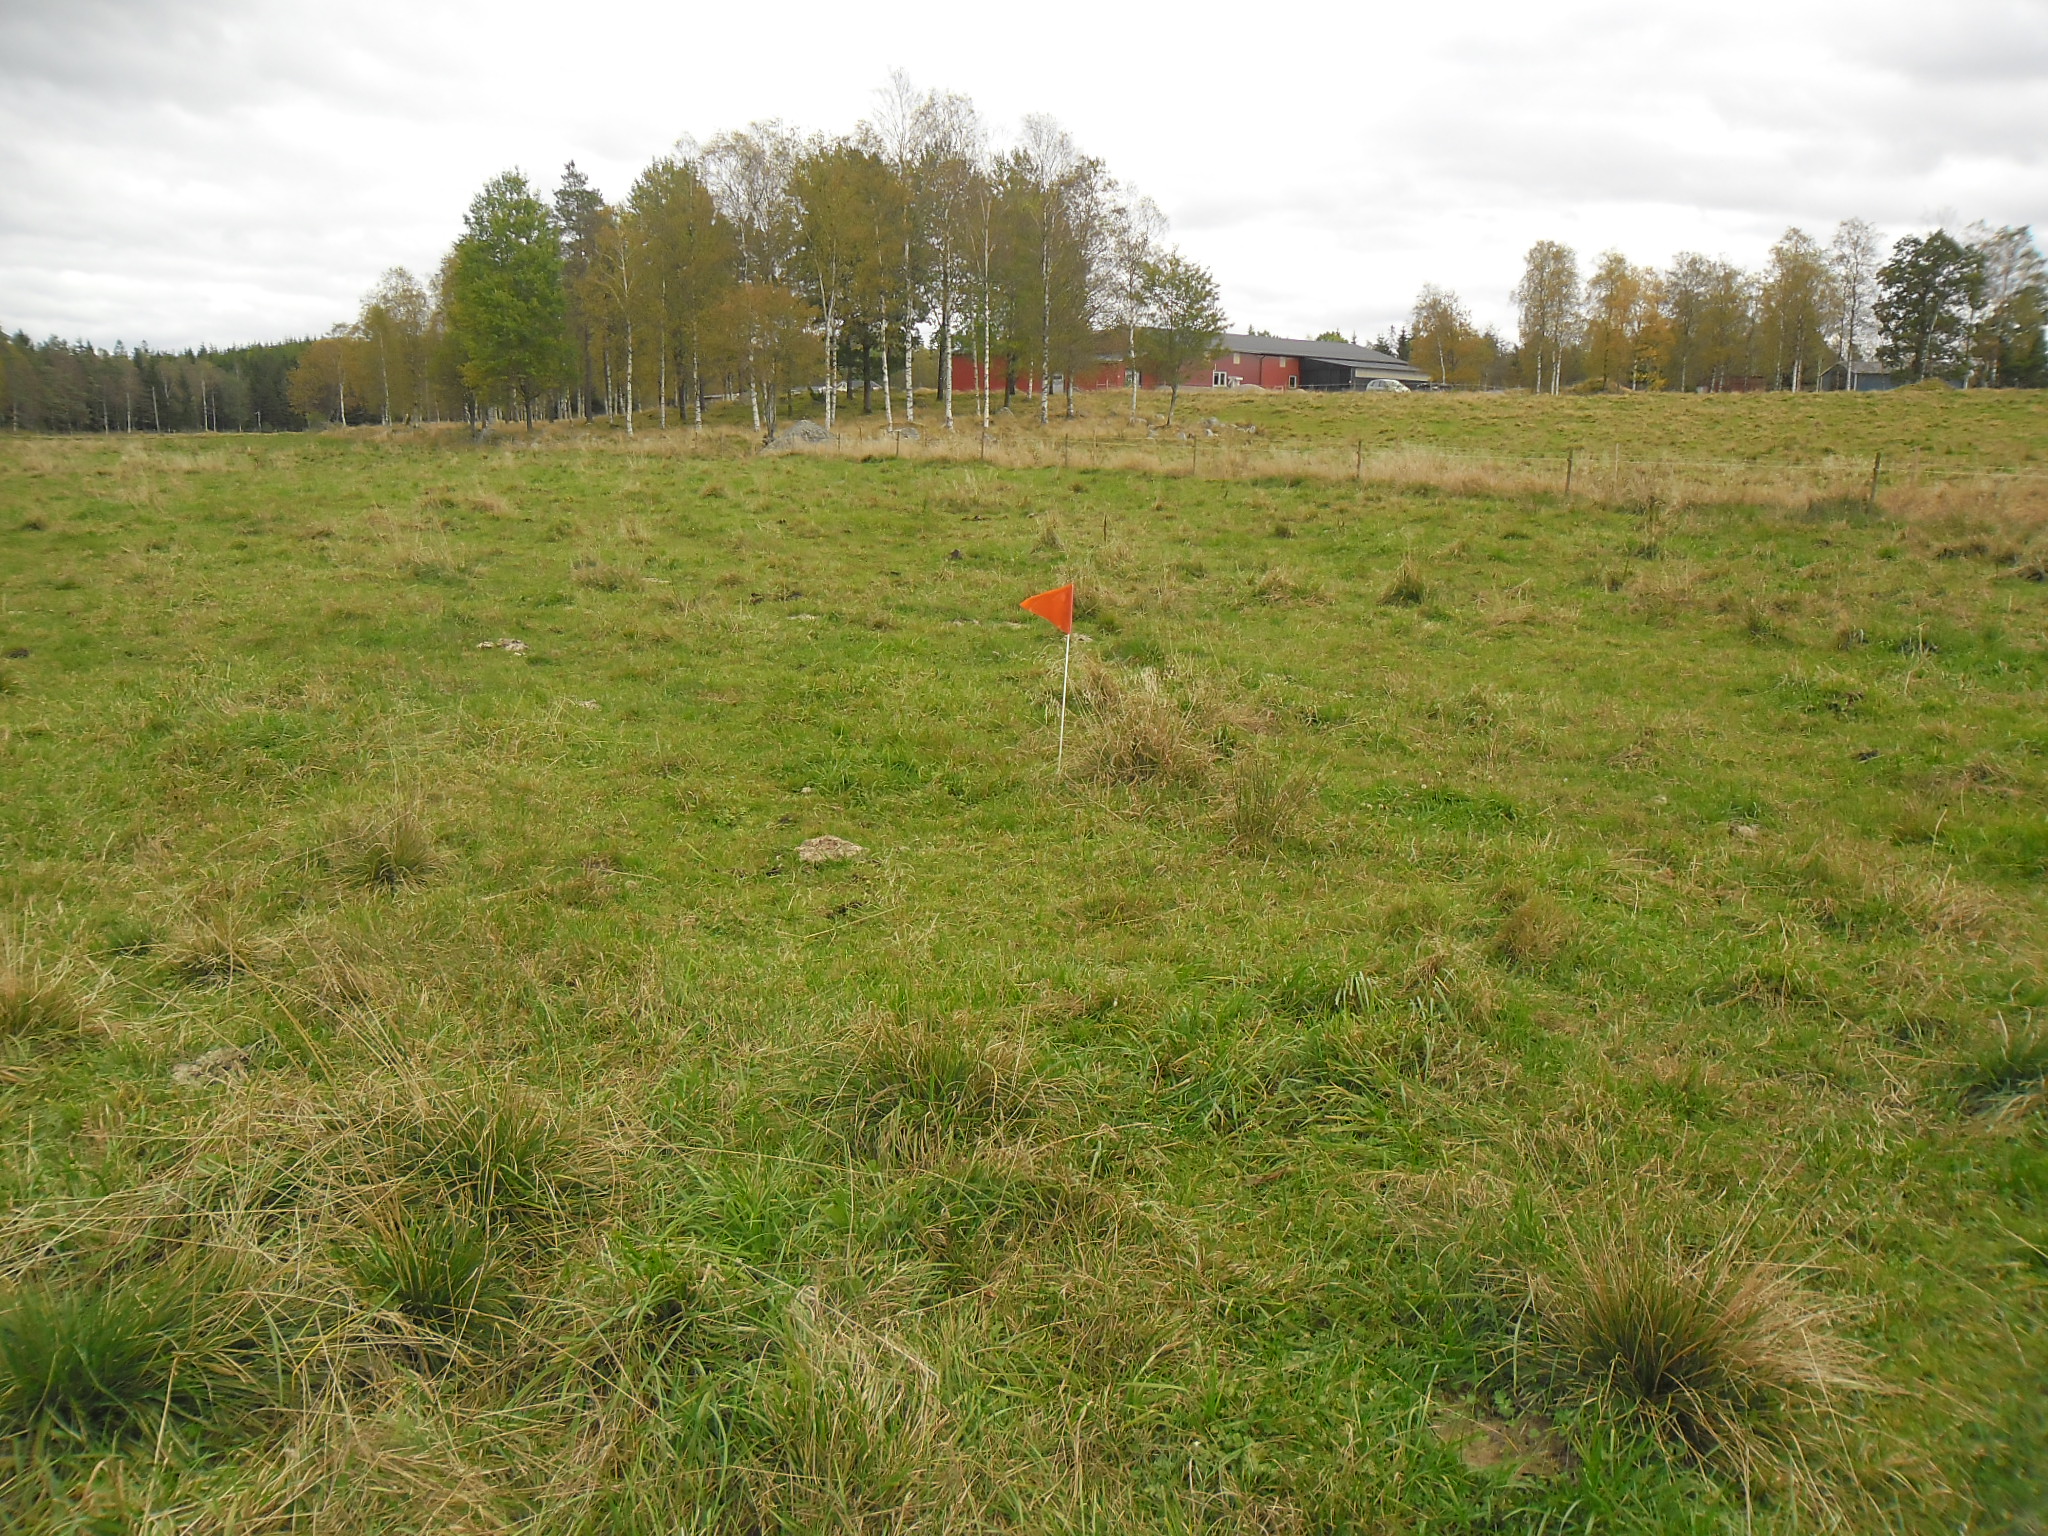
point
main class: Grassland
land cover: Grassland without tree/shrub cover
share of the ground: > 75 %
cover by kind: herbaceous plants 100 %
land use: Agriculture (excluding fallow land and kitchen gardens)
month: October
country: SE
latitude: 56.7061
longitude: 13.1819
